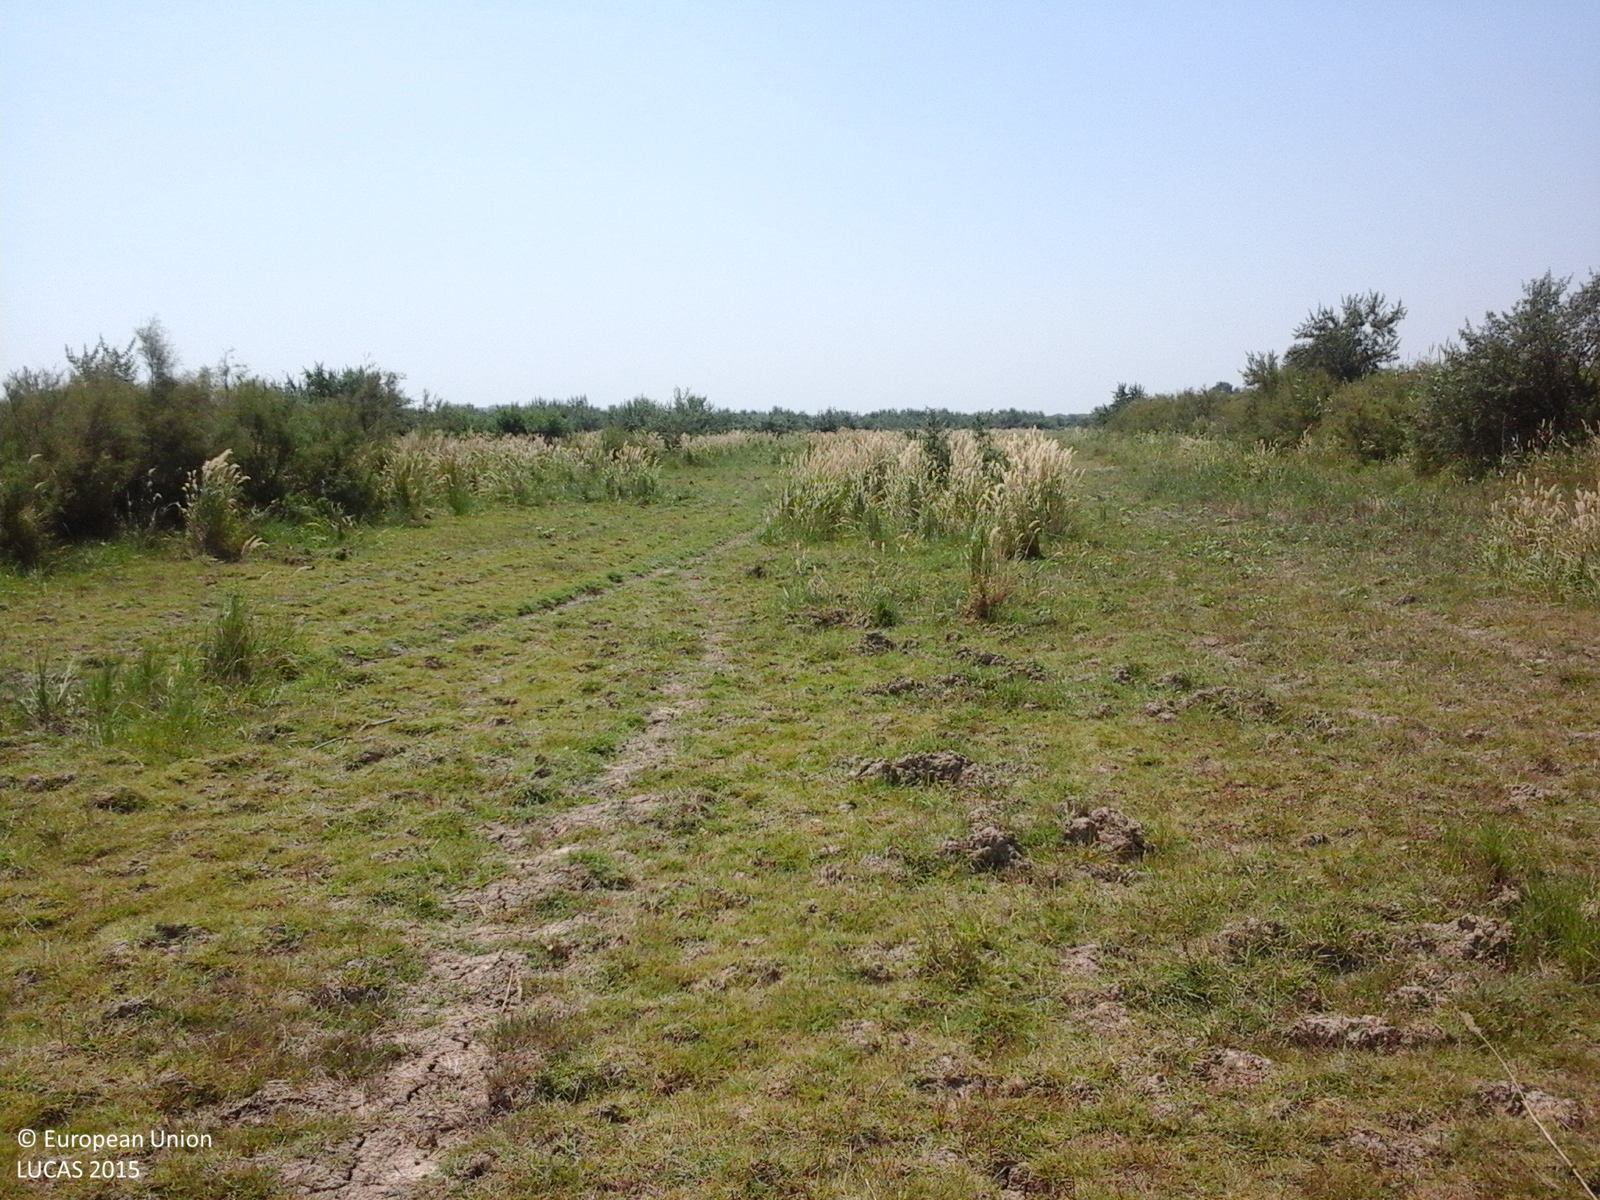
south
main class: Grassland
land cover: Spontaneously vegetated surfaces
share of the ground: > 75 %
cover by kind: herbaceous plants 100 %
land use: Agriculture (excluding fallow land and kitchen gardens)
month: August
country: RO
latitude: 45.2098
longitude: 27.3738
